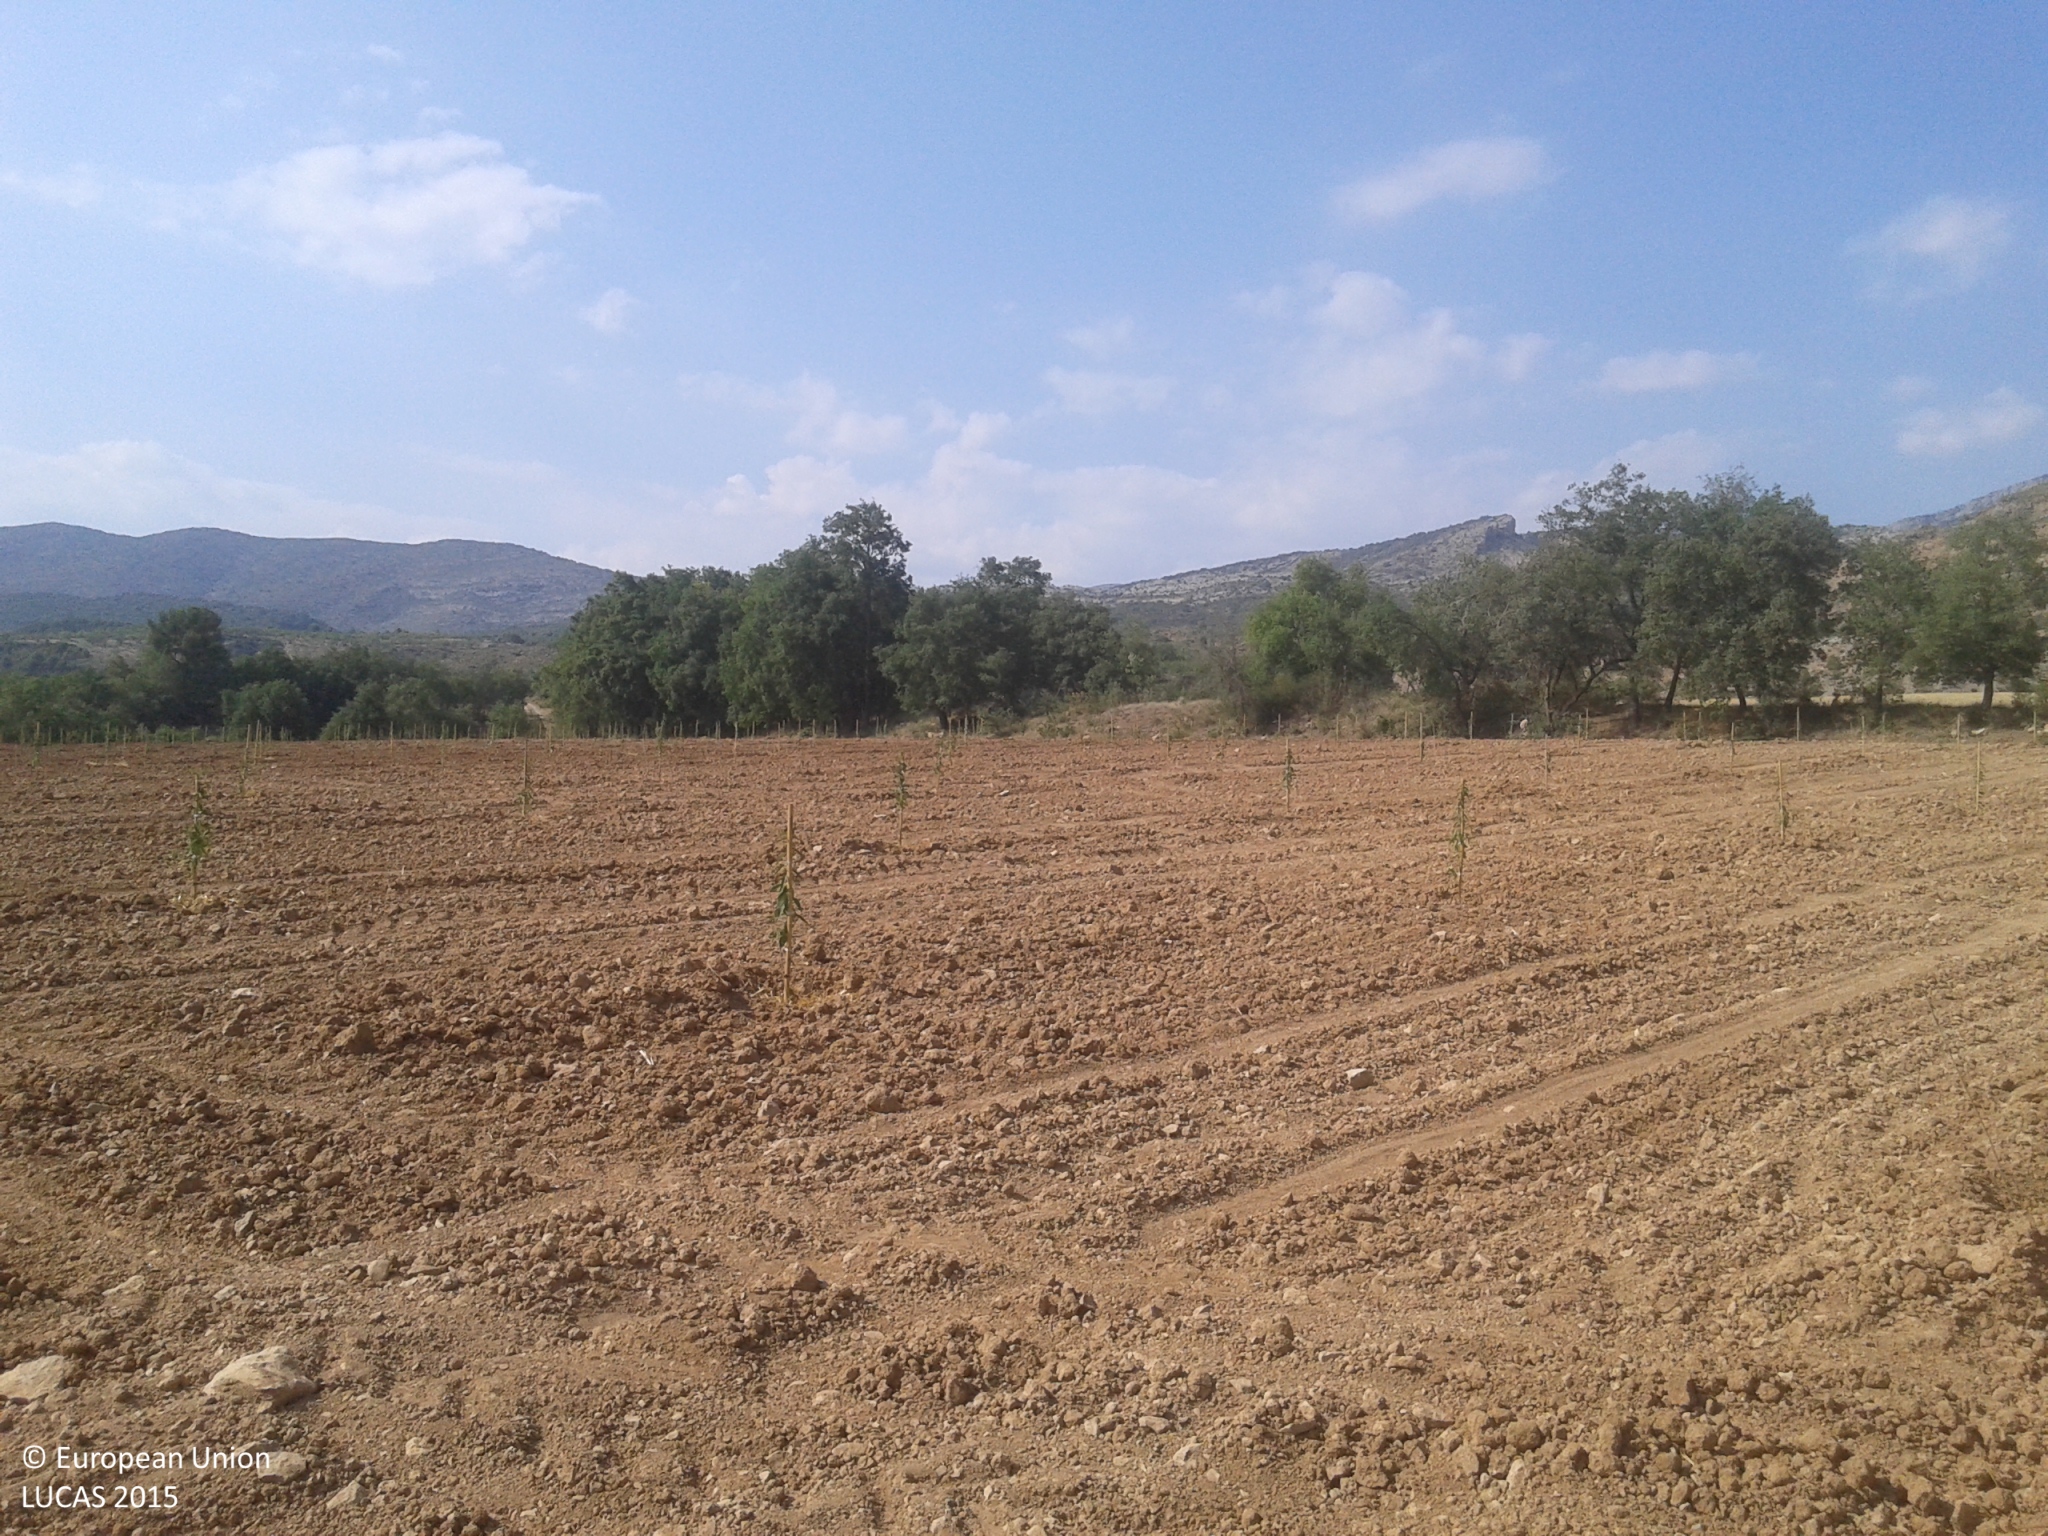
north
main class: Cropland
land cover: Nuts trees
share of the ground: < 10 %
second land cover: Other bare soil
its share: > 75 %
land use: Agriculture (excluding fallow land and kitchen gardens)
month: July
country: ES
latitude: 42.1475
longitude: 1.0431
